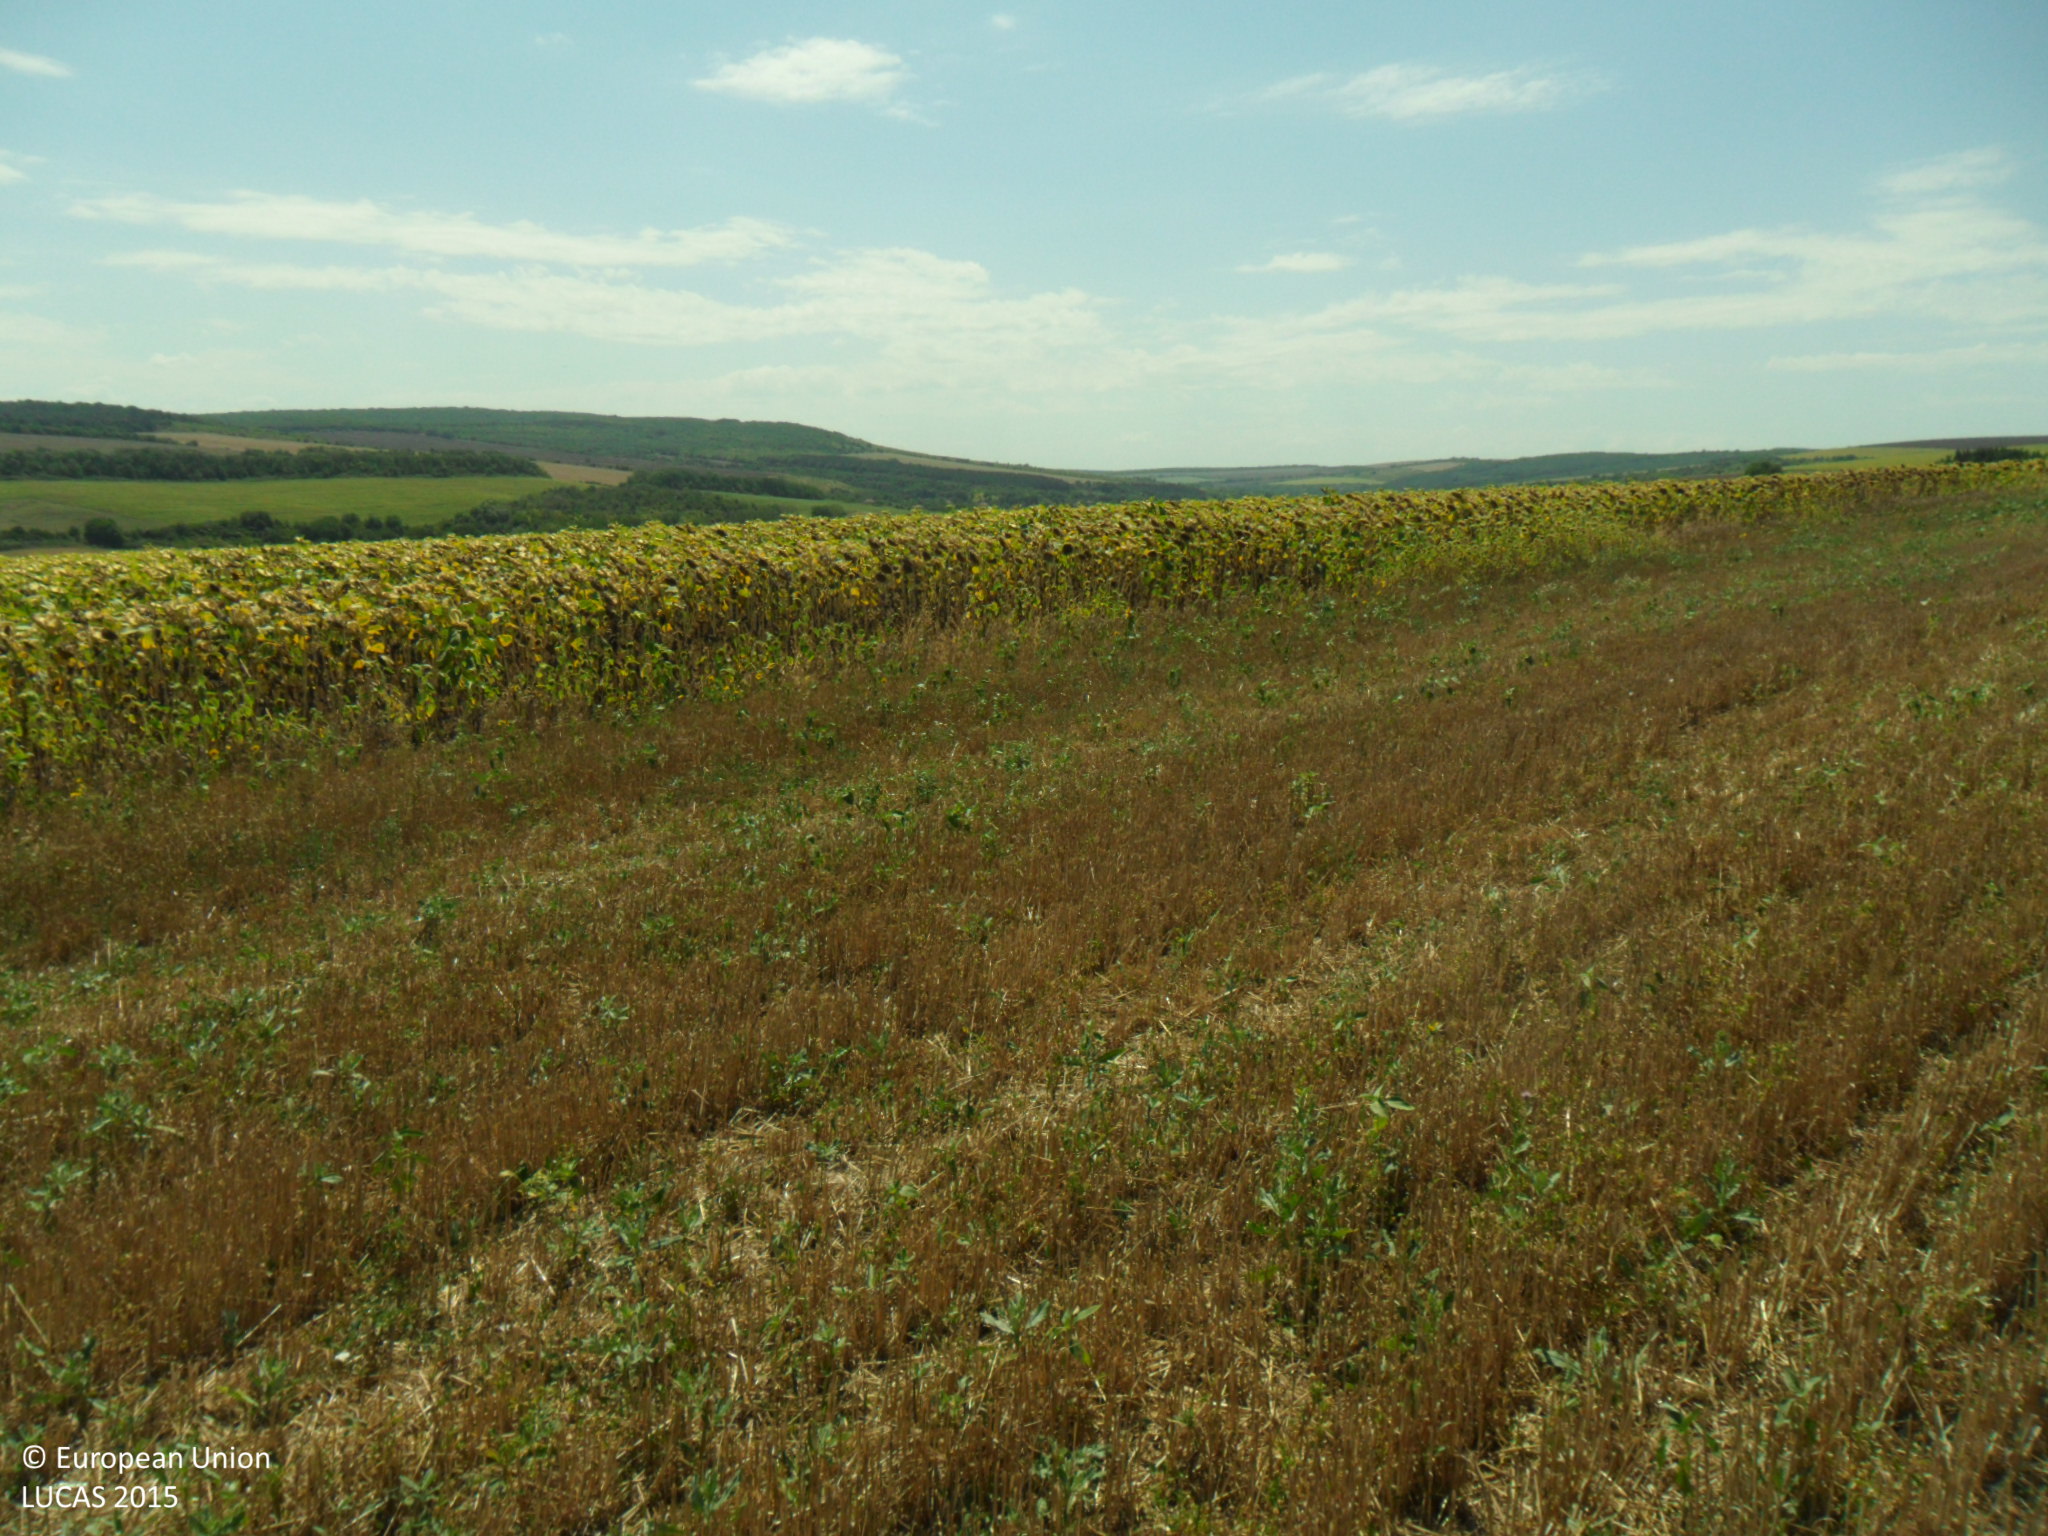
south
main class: Cropland
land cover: Common wheat
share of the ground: 25 - 50 %
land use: Agriculture (excluding fallow land and kitchen gardens)
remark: Harvested field
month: August
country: BG
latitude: 43.5489
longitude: 26.4040
